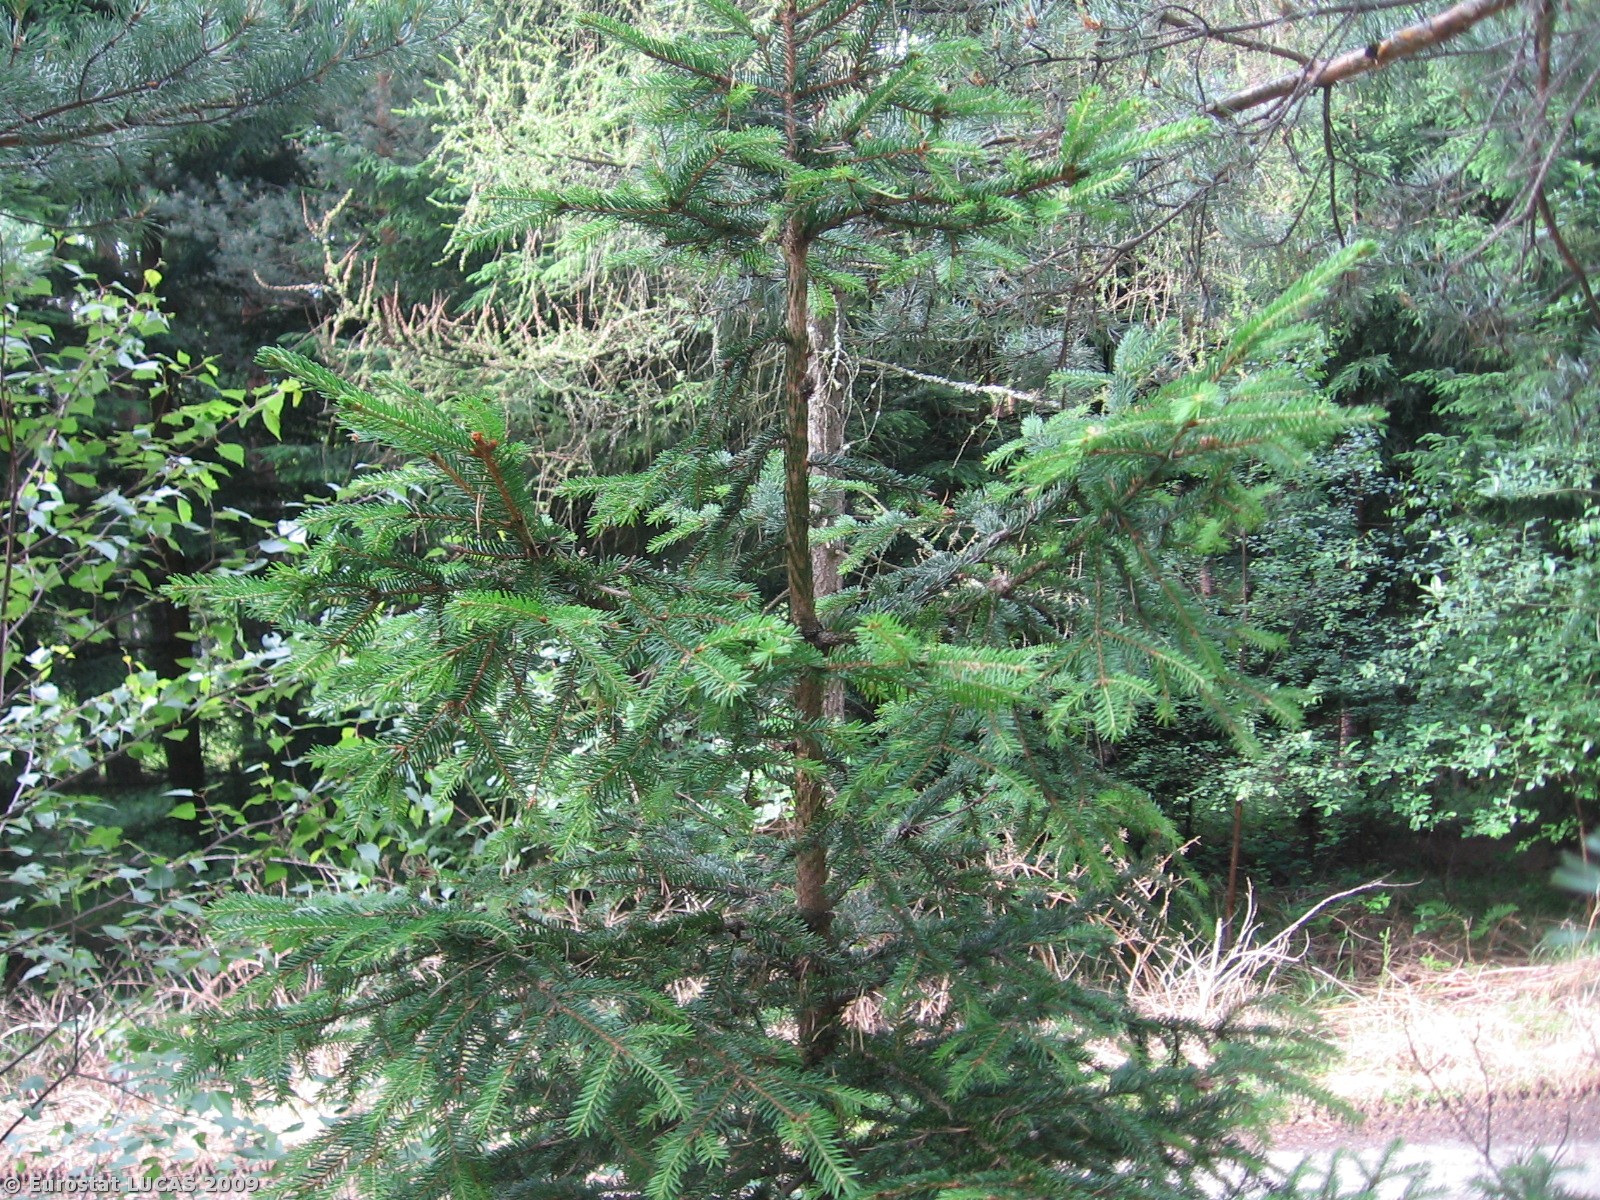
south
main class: Woodland
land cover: Coniferous woodland
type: hemiboreal forest and nemoral coniferous forest and mixed broadleaved-coniferous forest
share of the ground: > 75 %
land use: Forestry
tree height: > 5 m
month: June
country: CZ
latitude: 49.1289
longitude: 13.8513
